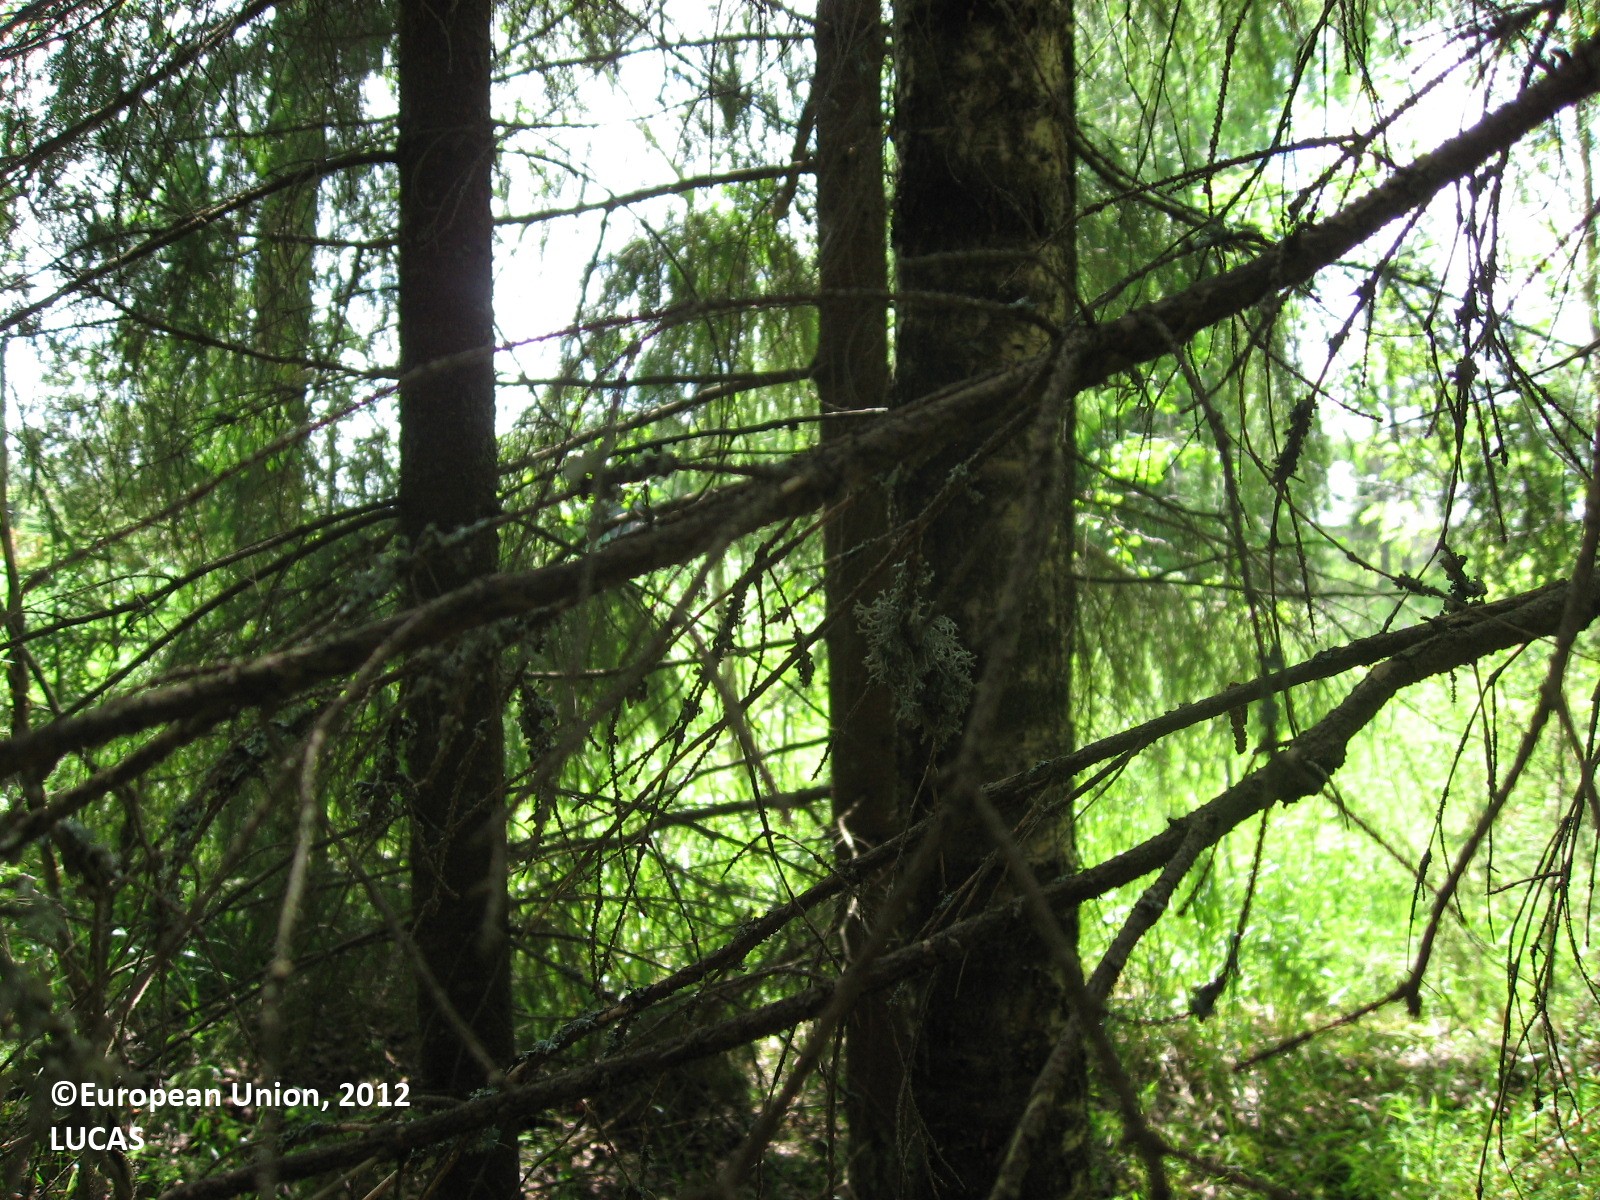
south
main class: Woodland
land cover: Spruce dominated mixed woodland
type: boreal forest
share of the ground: > 75 %
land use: Forestry
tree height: > 5 m
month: June
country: FI
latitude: 60.6452
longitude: 26.5980
